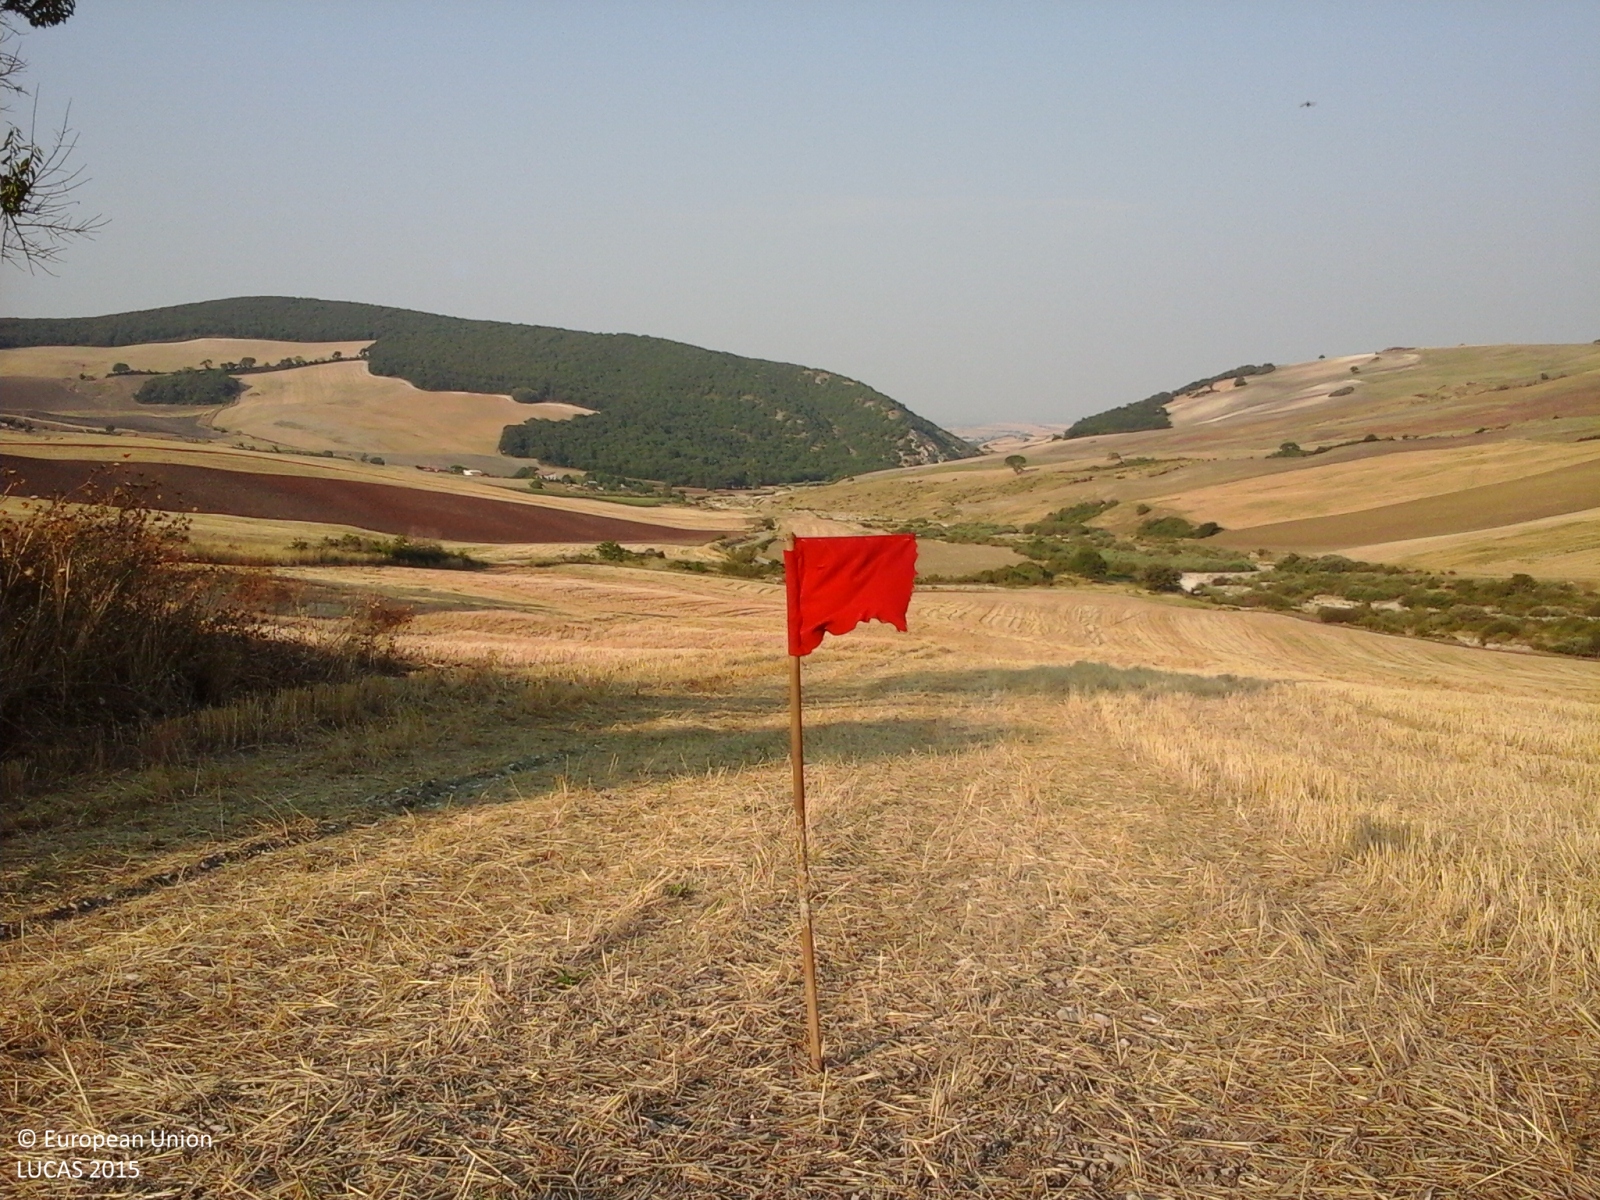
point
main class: Cropland
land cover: Durum wheat
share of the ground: > 75 %
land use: Agriculture (excluding fallow land and kitchen gardens)
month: August
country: IT
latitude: 41.4013
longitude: 15.1376
